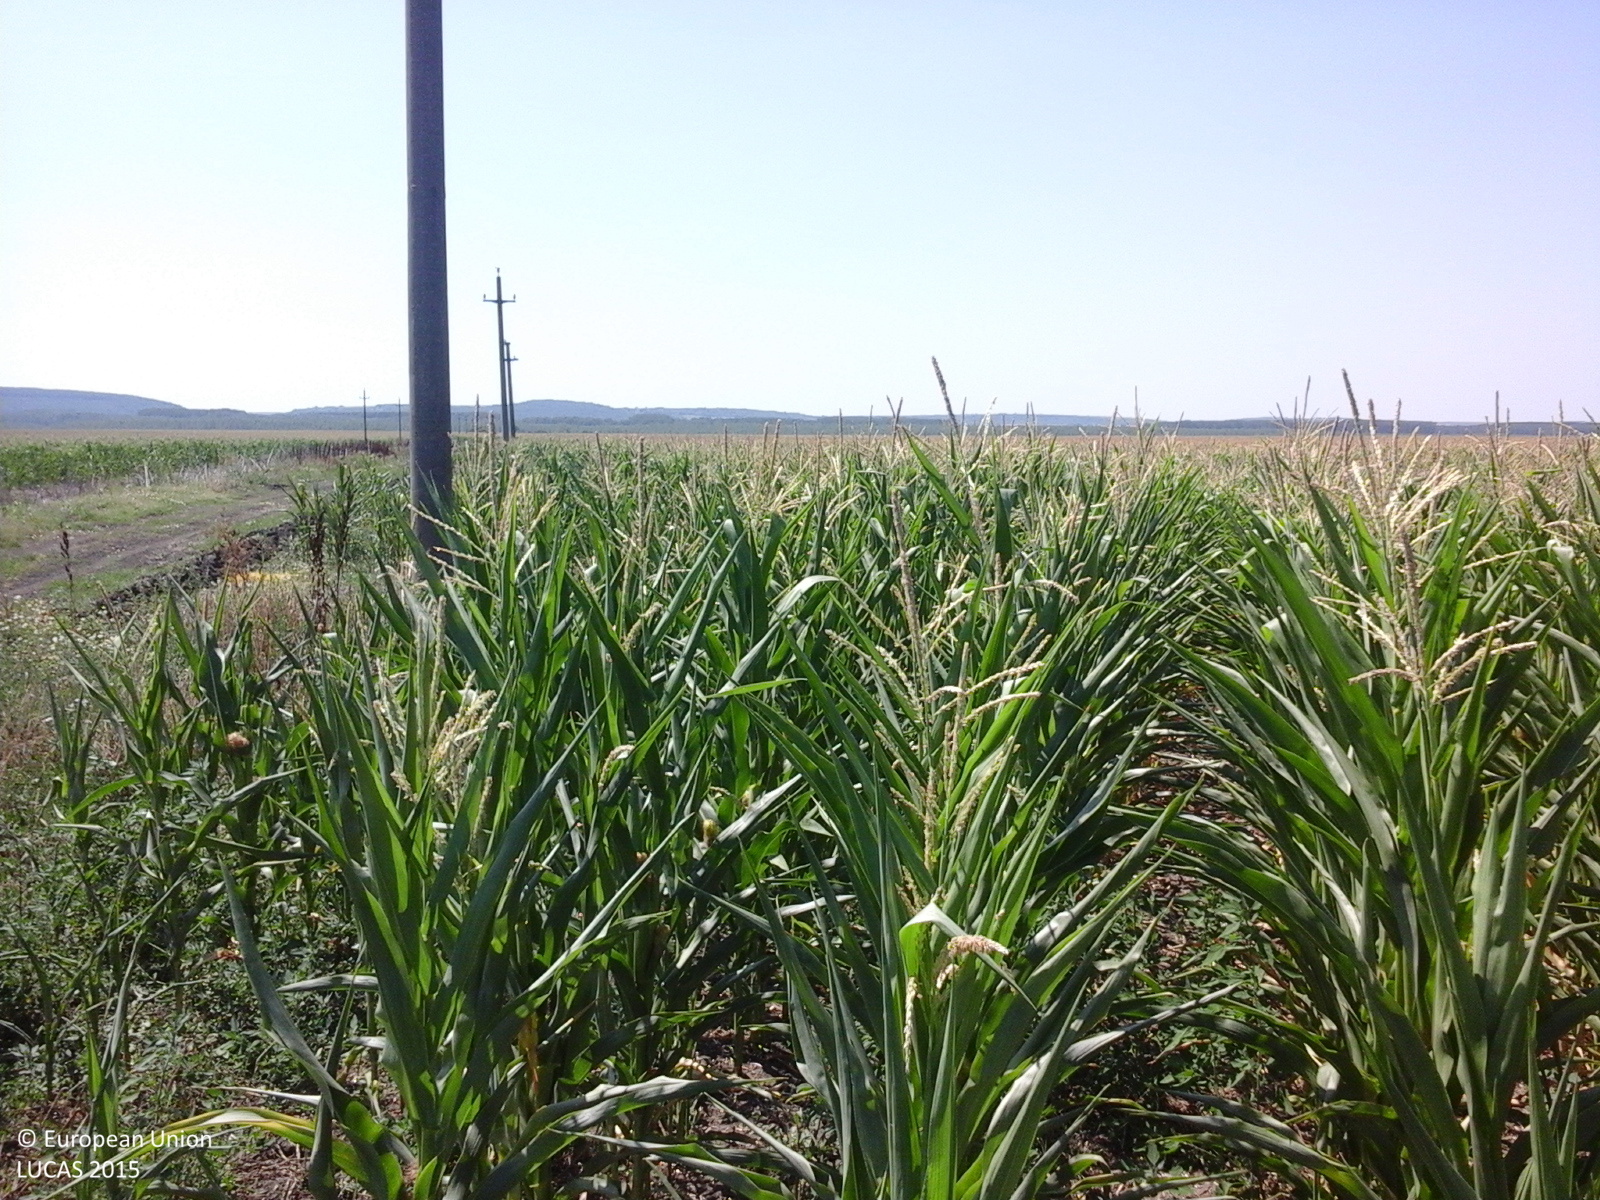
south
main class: Cropland
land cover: Maize
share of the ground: > 75 %
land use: Agriculture (excluding fallow land and kitchen gardens)
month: July
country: RO
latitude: 44.1687
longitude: 26.9962
